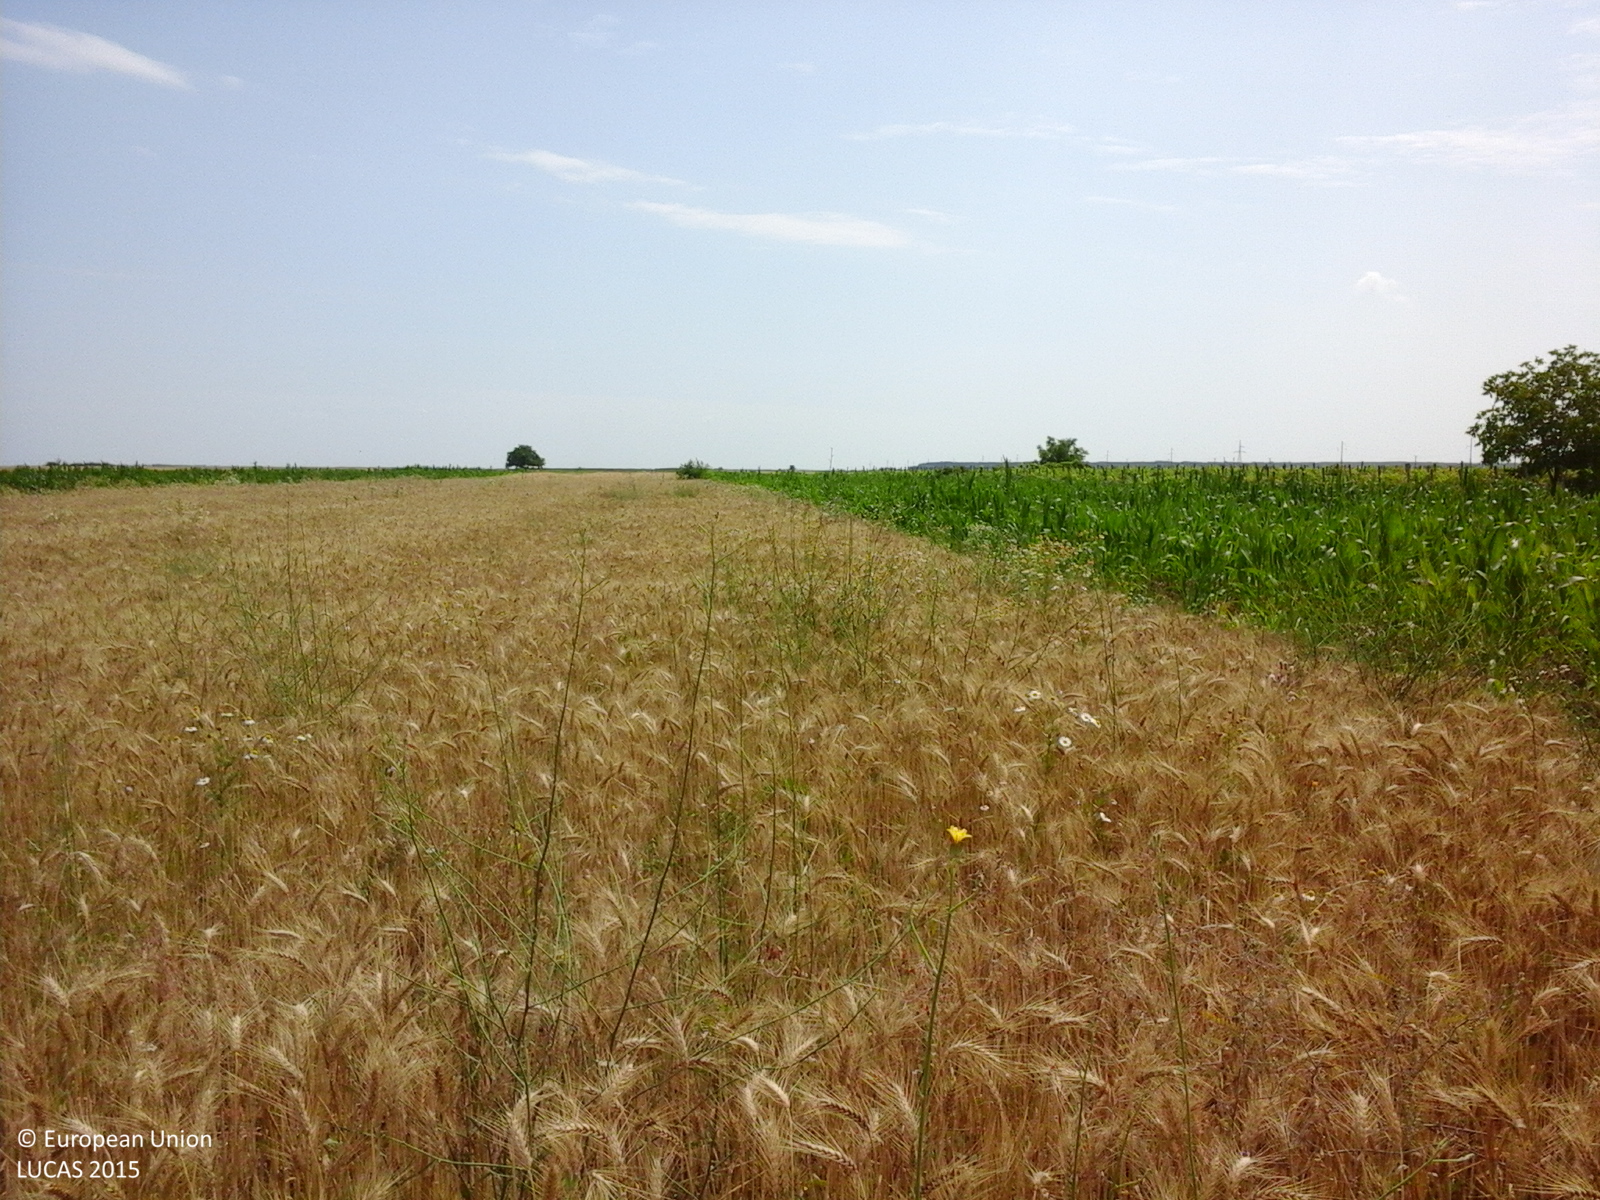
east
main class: Cropland
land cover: Common wheat
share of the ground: > 75 %
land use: Agriculture (excluding fallow land and kitchen gardens)
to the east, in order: Common wheat; Maize; Vineyards; Lucerne; Tracks; Grass margins; Maize
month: June
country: RO
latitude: 44.1595
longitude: 26.3772
